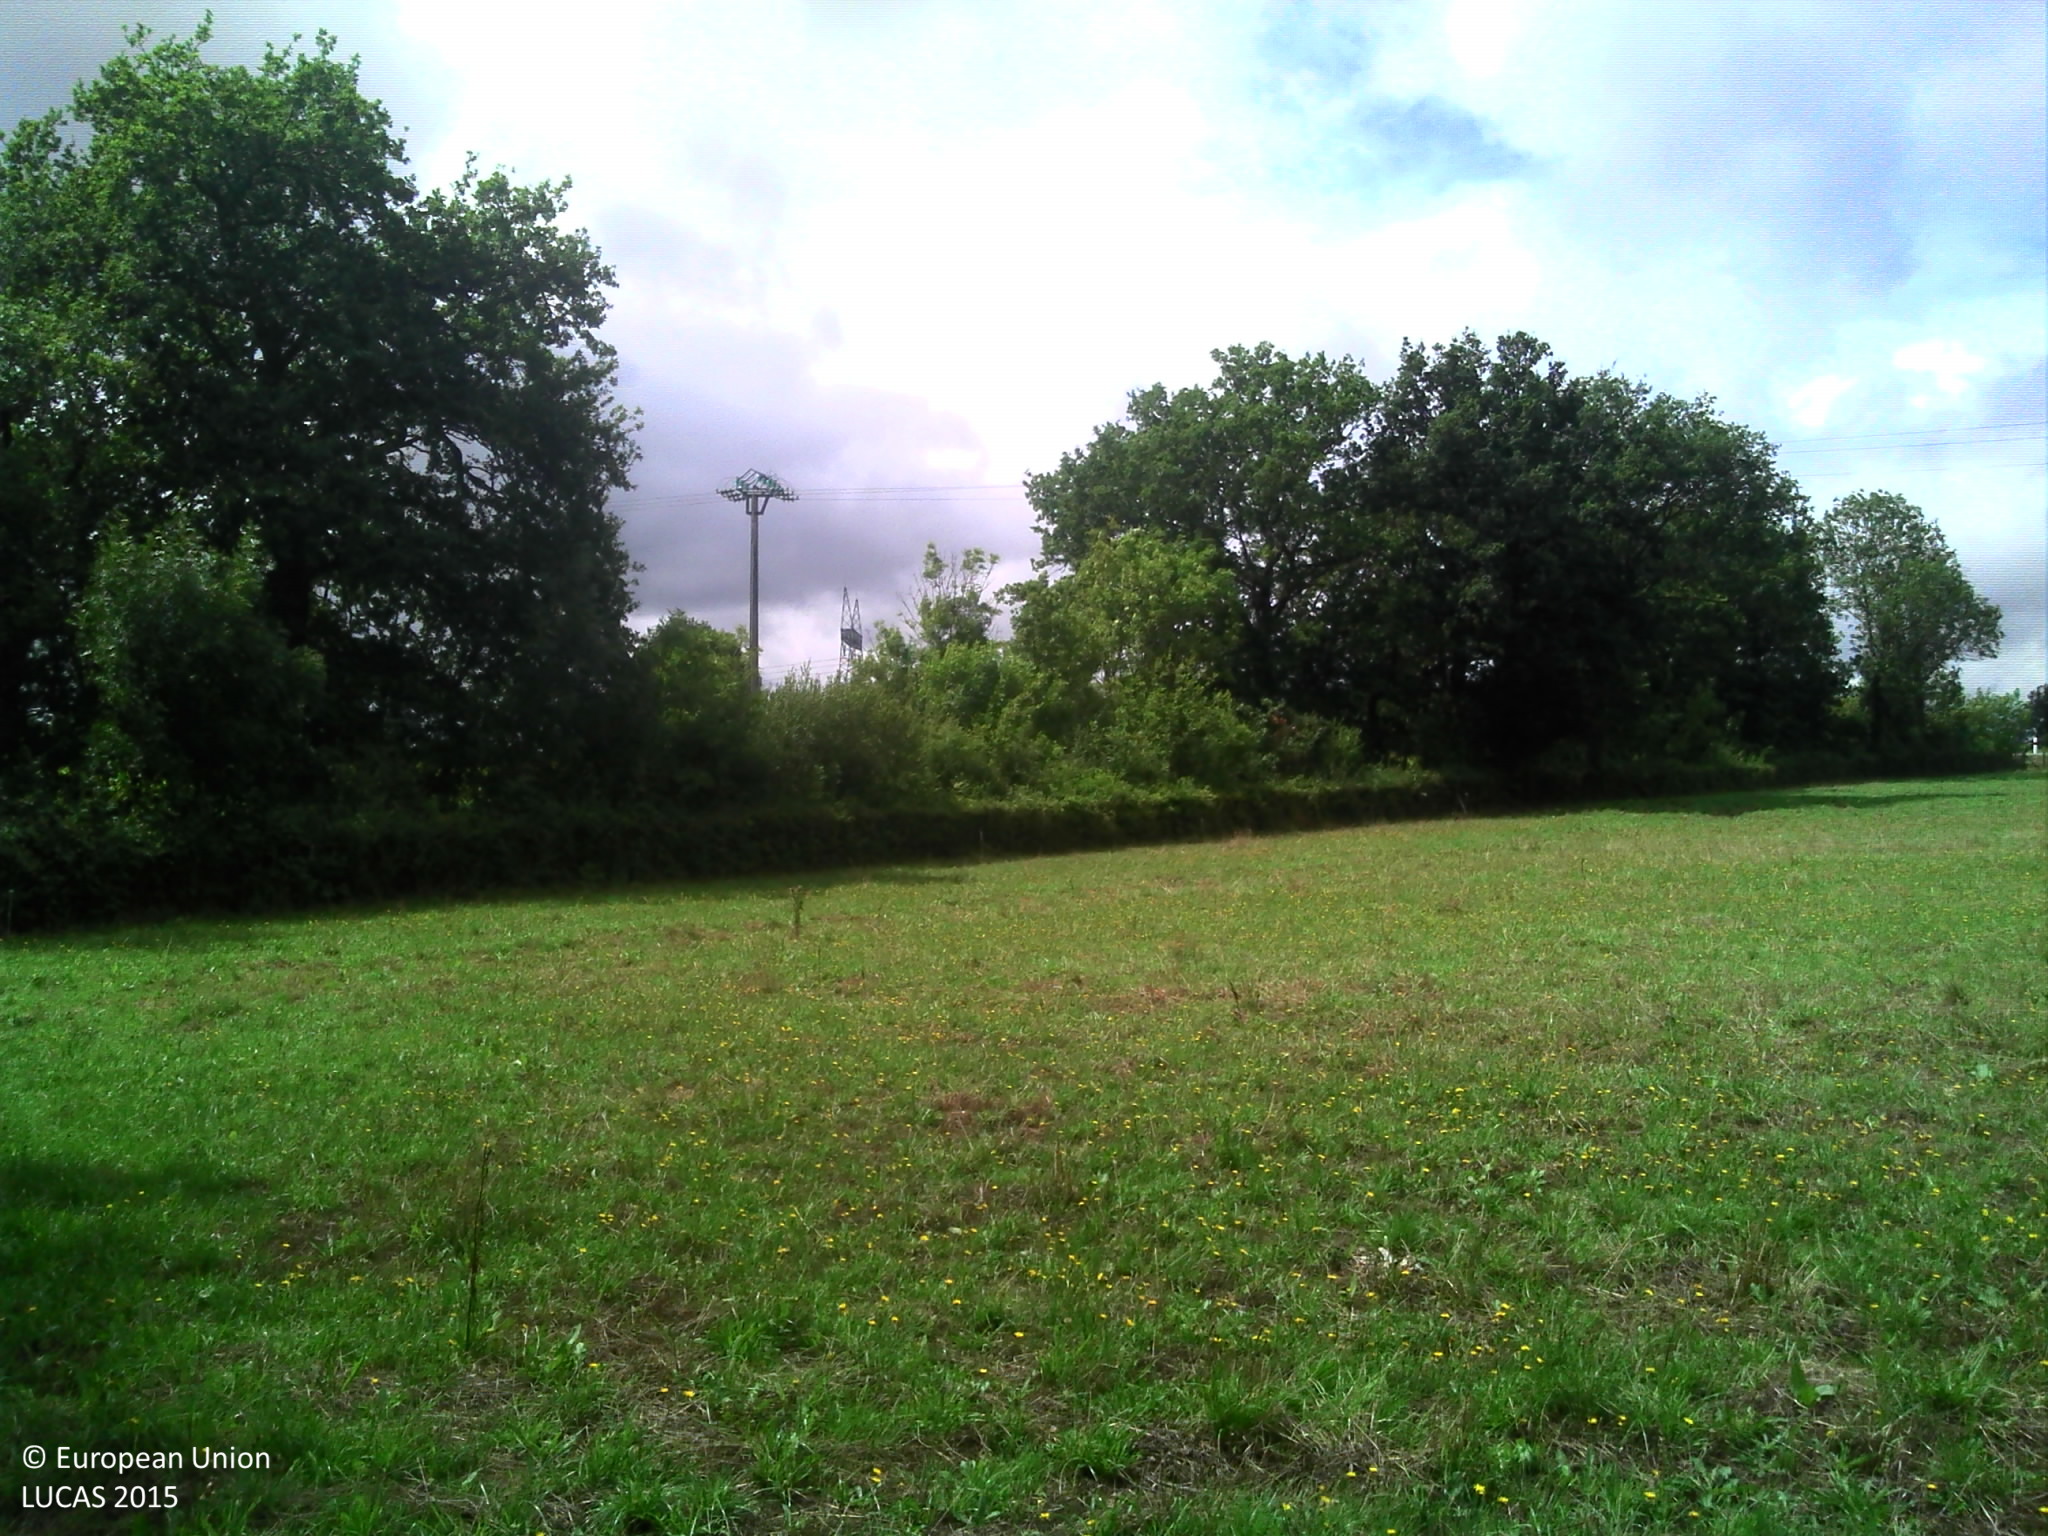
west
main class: Grassland
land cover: Grassland without tree/shrub cover
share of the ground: > 75 %
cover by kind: herbaceous plants 100 %
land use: Agriculture (excluding fallow land and kitchen gardens)
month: August
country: FR
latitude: 46.1575
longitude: 2.2124
